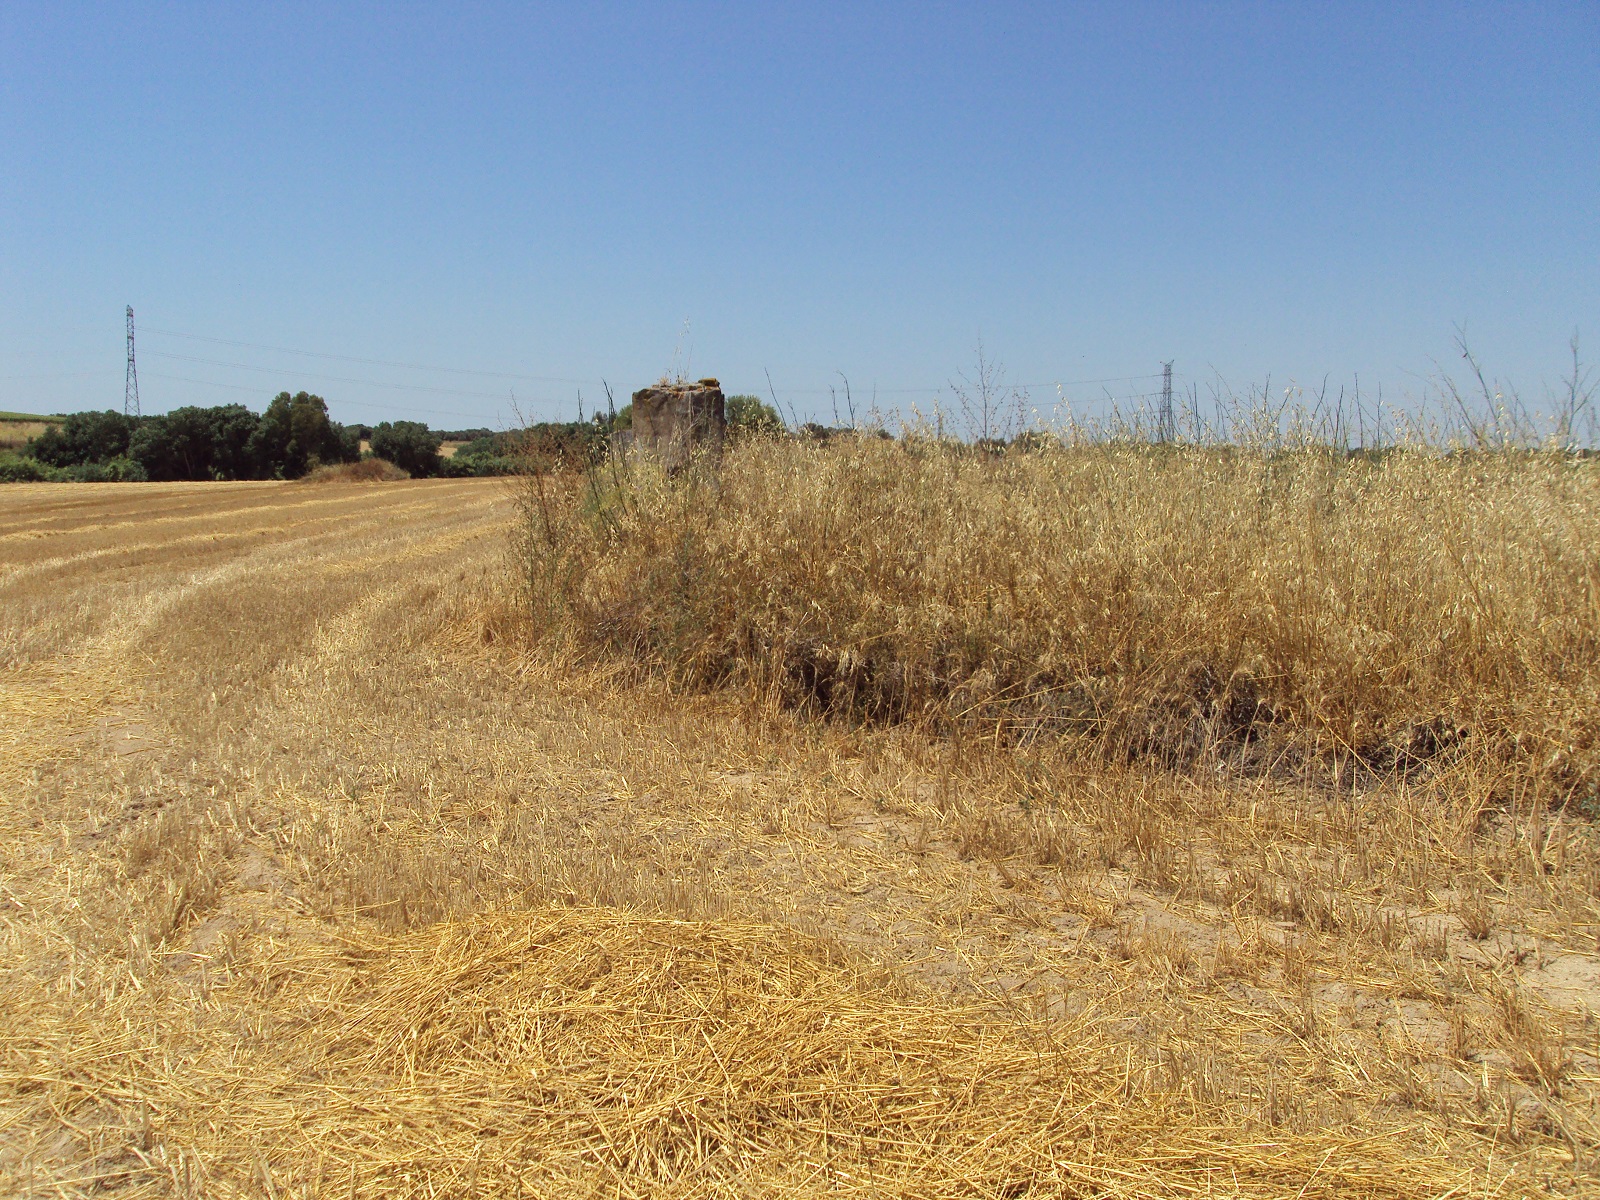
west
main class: Cropland
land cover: Durum wheat
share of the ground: > 75 %
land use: Agriculture (excluding fallow land and kitchen gardens)
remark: Harvested field
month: June
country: ES
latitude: 37.3727
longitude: -6.8761
